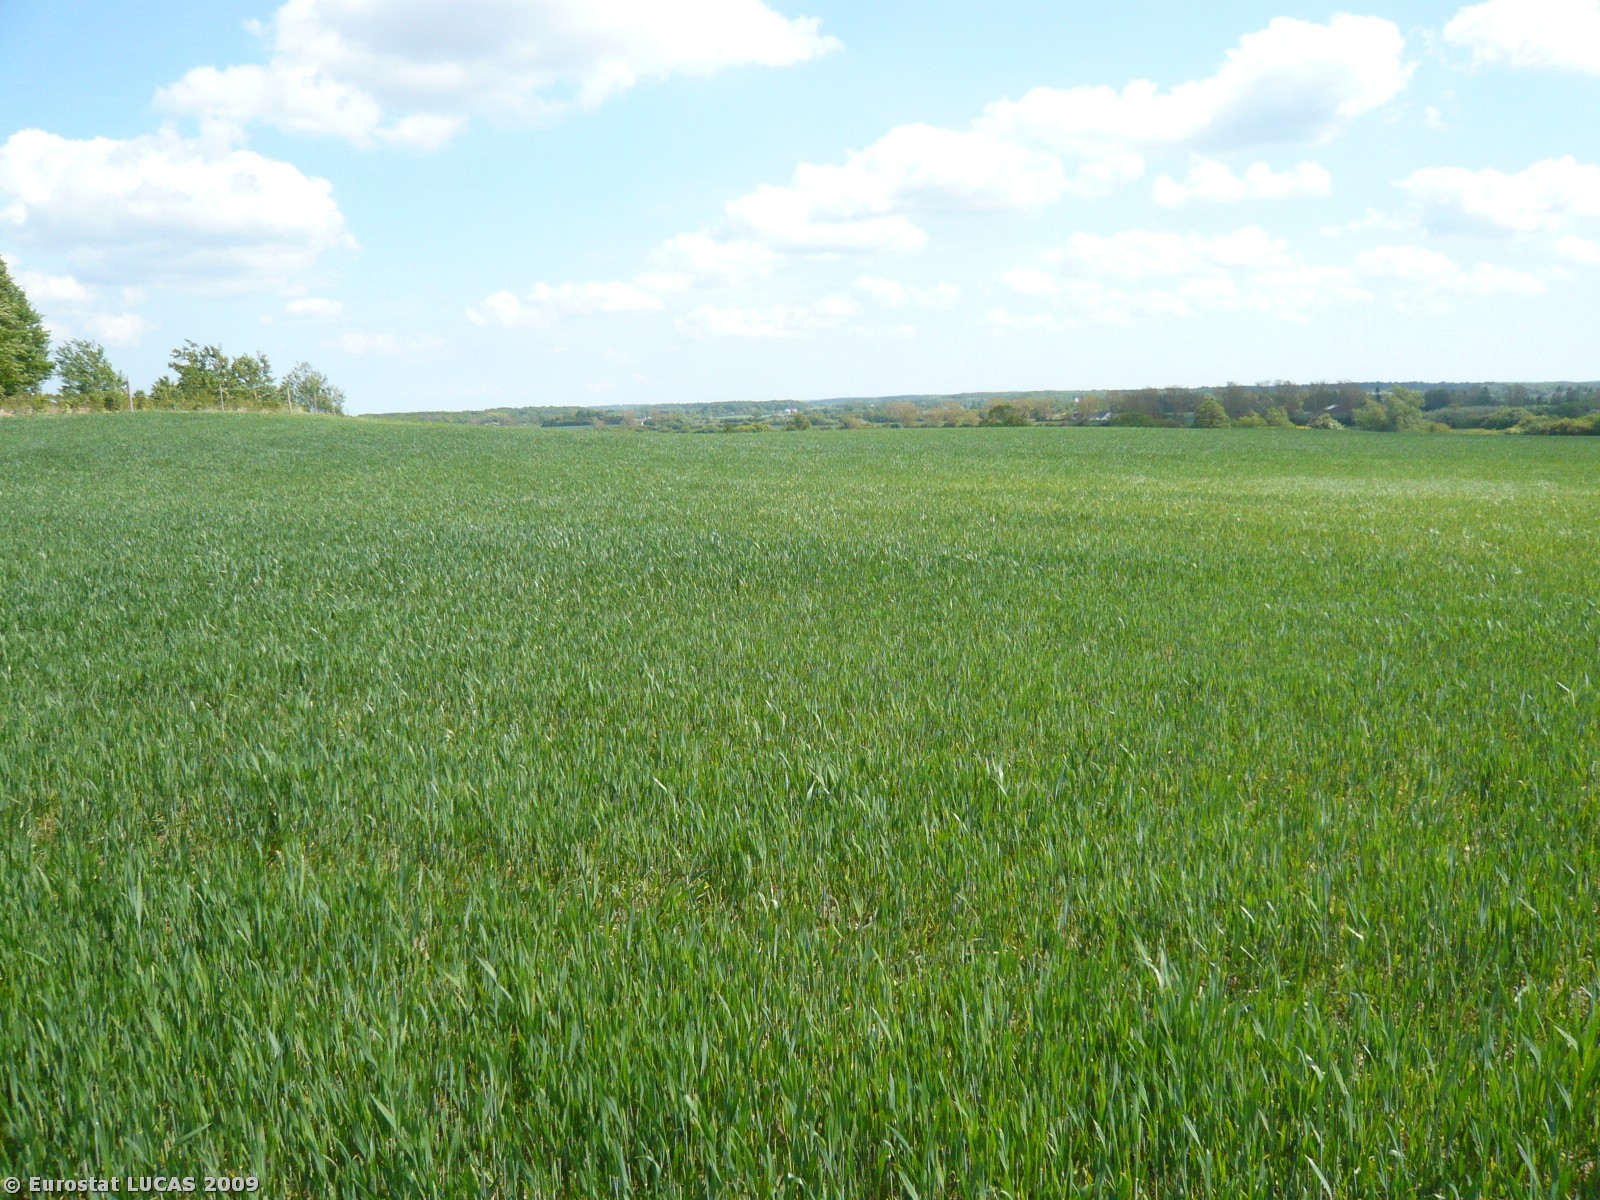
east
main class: Cropland
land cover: Common wheat
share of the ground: > 75 %
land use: Agriculture (excluding fallow land and kitchen gardens)
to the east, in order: Common wheat; Fences; Shrubland with sparse tree cover; Fences; Common wheat
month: May
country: DK
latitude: 55.3979
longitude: 12.0669
